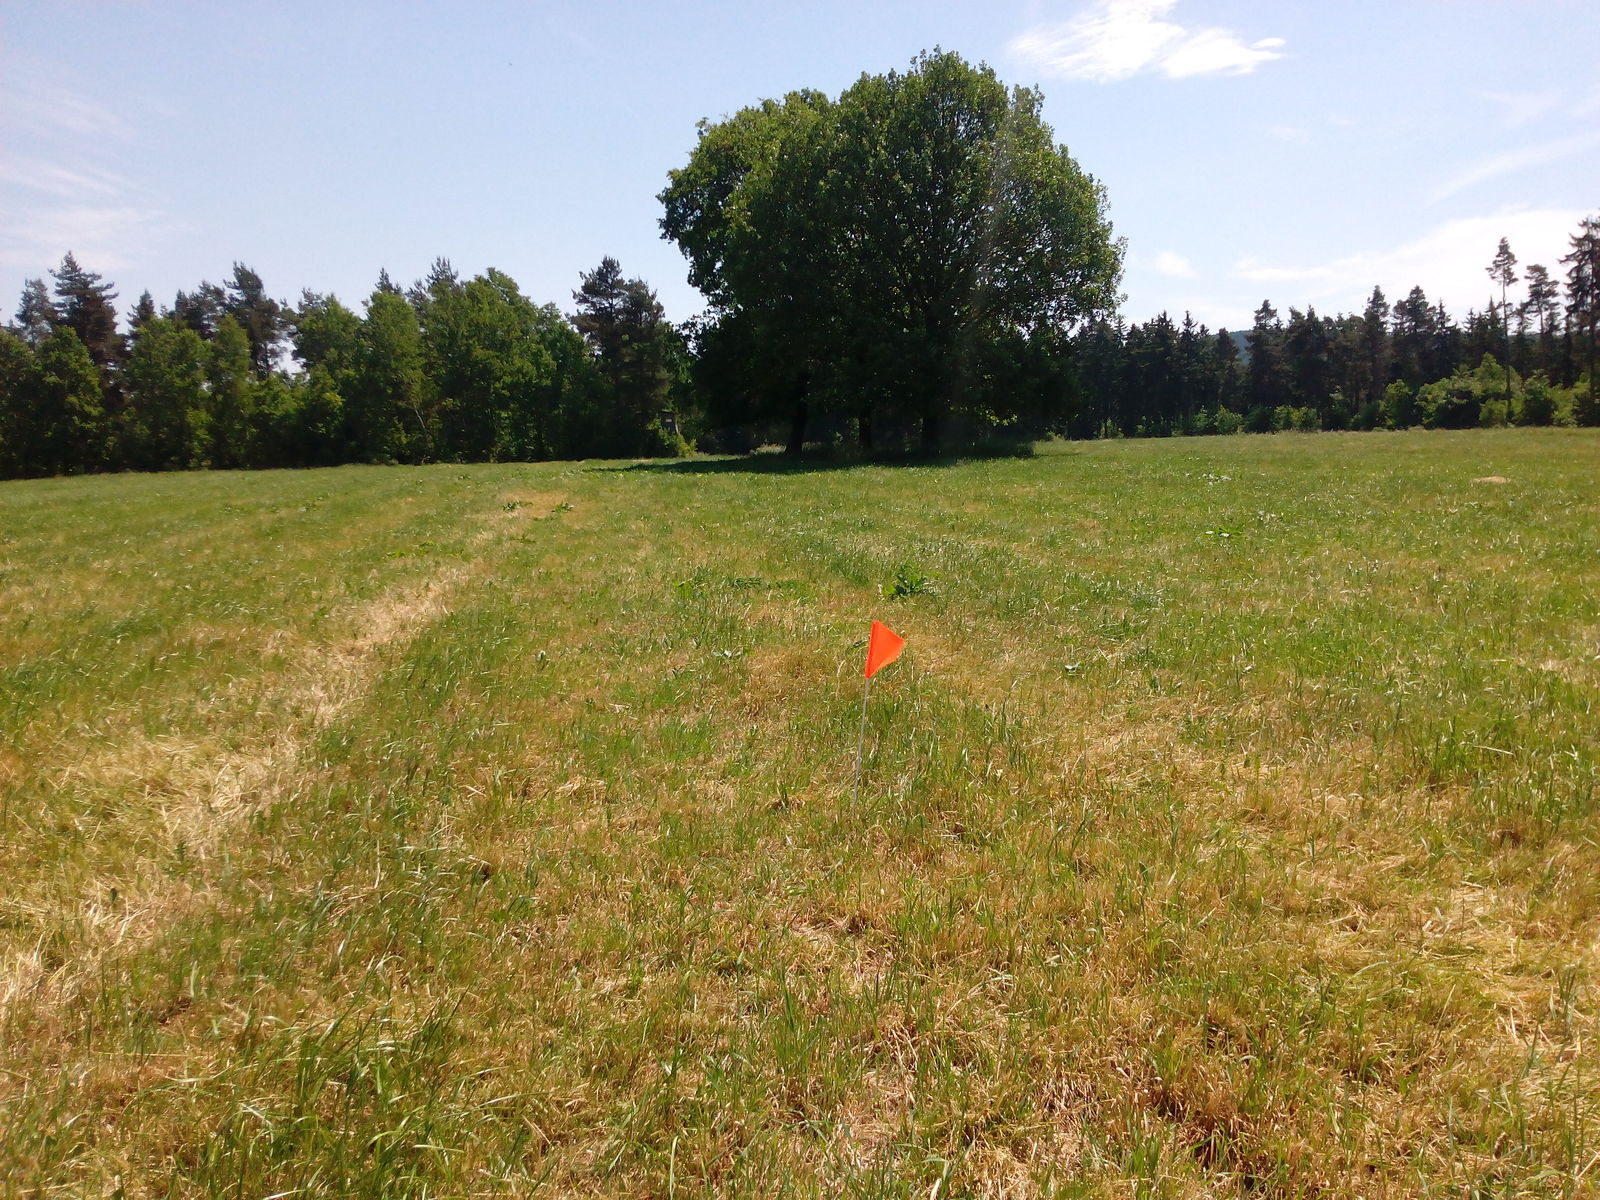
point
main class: Grassland
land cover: Grassland without tree/shrub cover
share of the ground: > 75 %
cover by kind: herbaceous plants 100 %
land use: Agriculture (excluding fallow land and kitchen gardens)
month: June
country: DE
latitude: 50.8297
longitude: 10.6387
